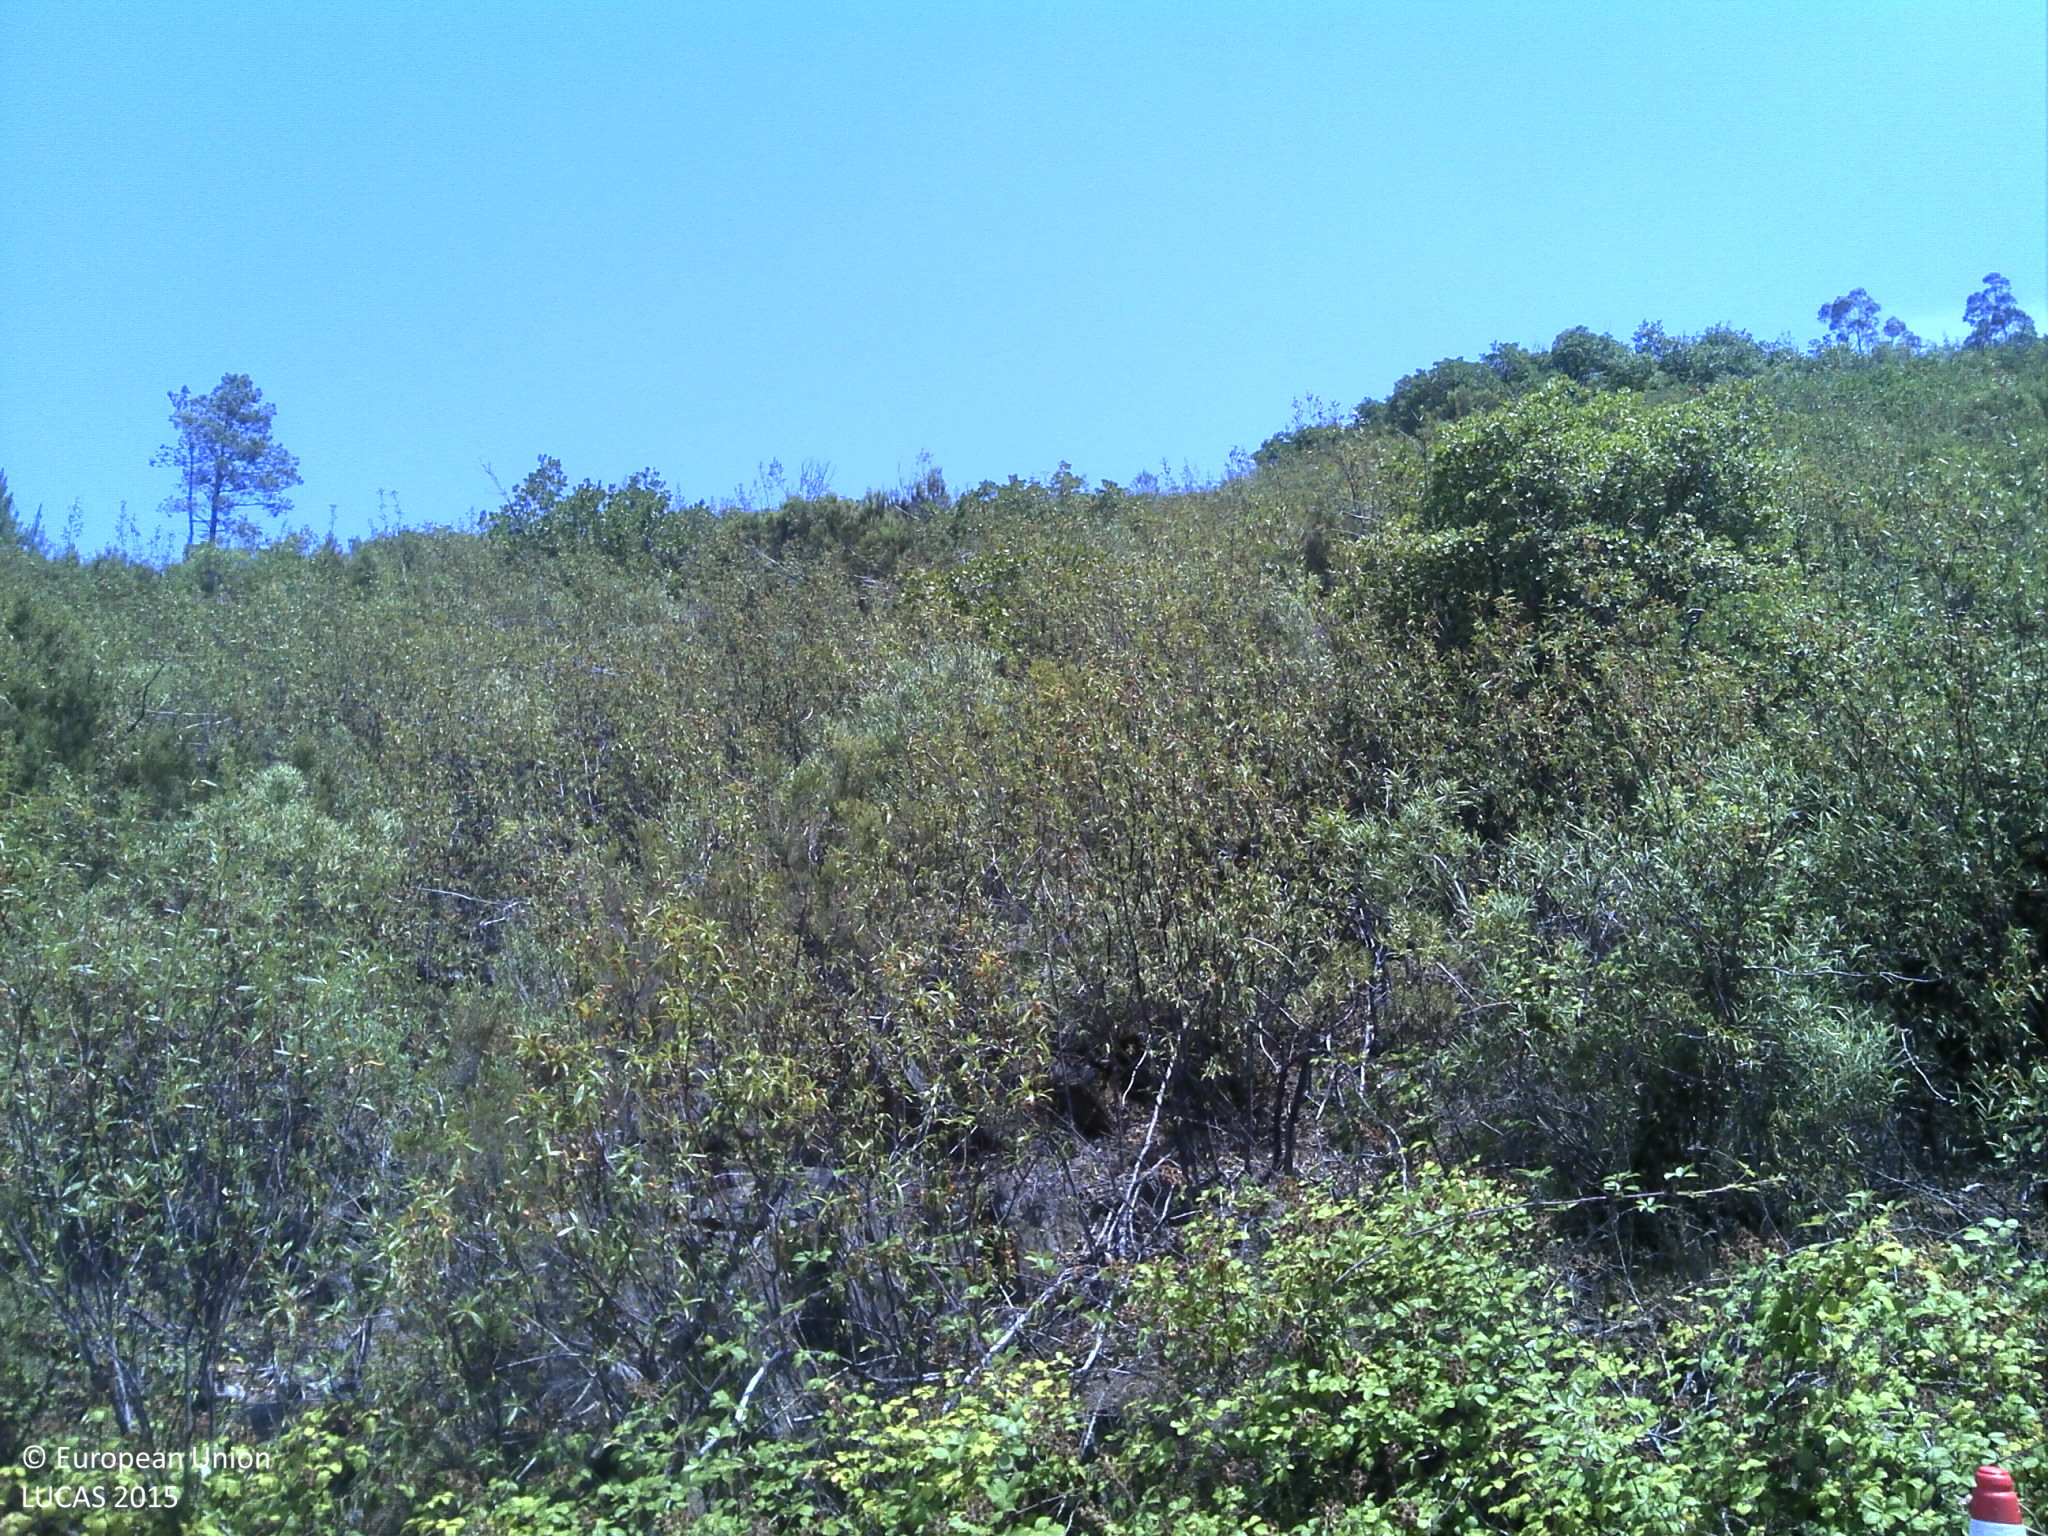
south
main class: Shrubland
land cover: Shrubland without tree cover
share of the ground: > 75 %
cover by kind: shrubs 90 %, unconsolidated bare surface 10 %
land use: Abandoned areas
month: July
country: PT
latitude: 40.0613
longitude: -7.9225
